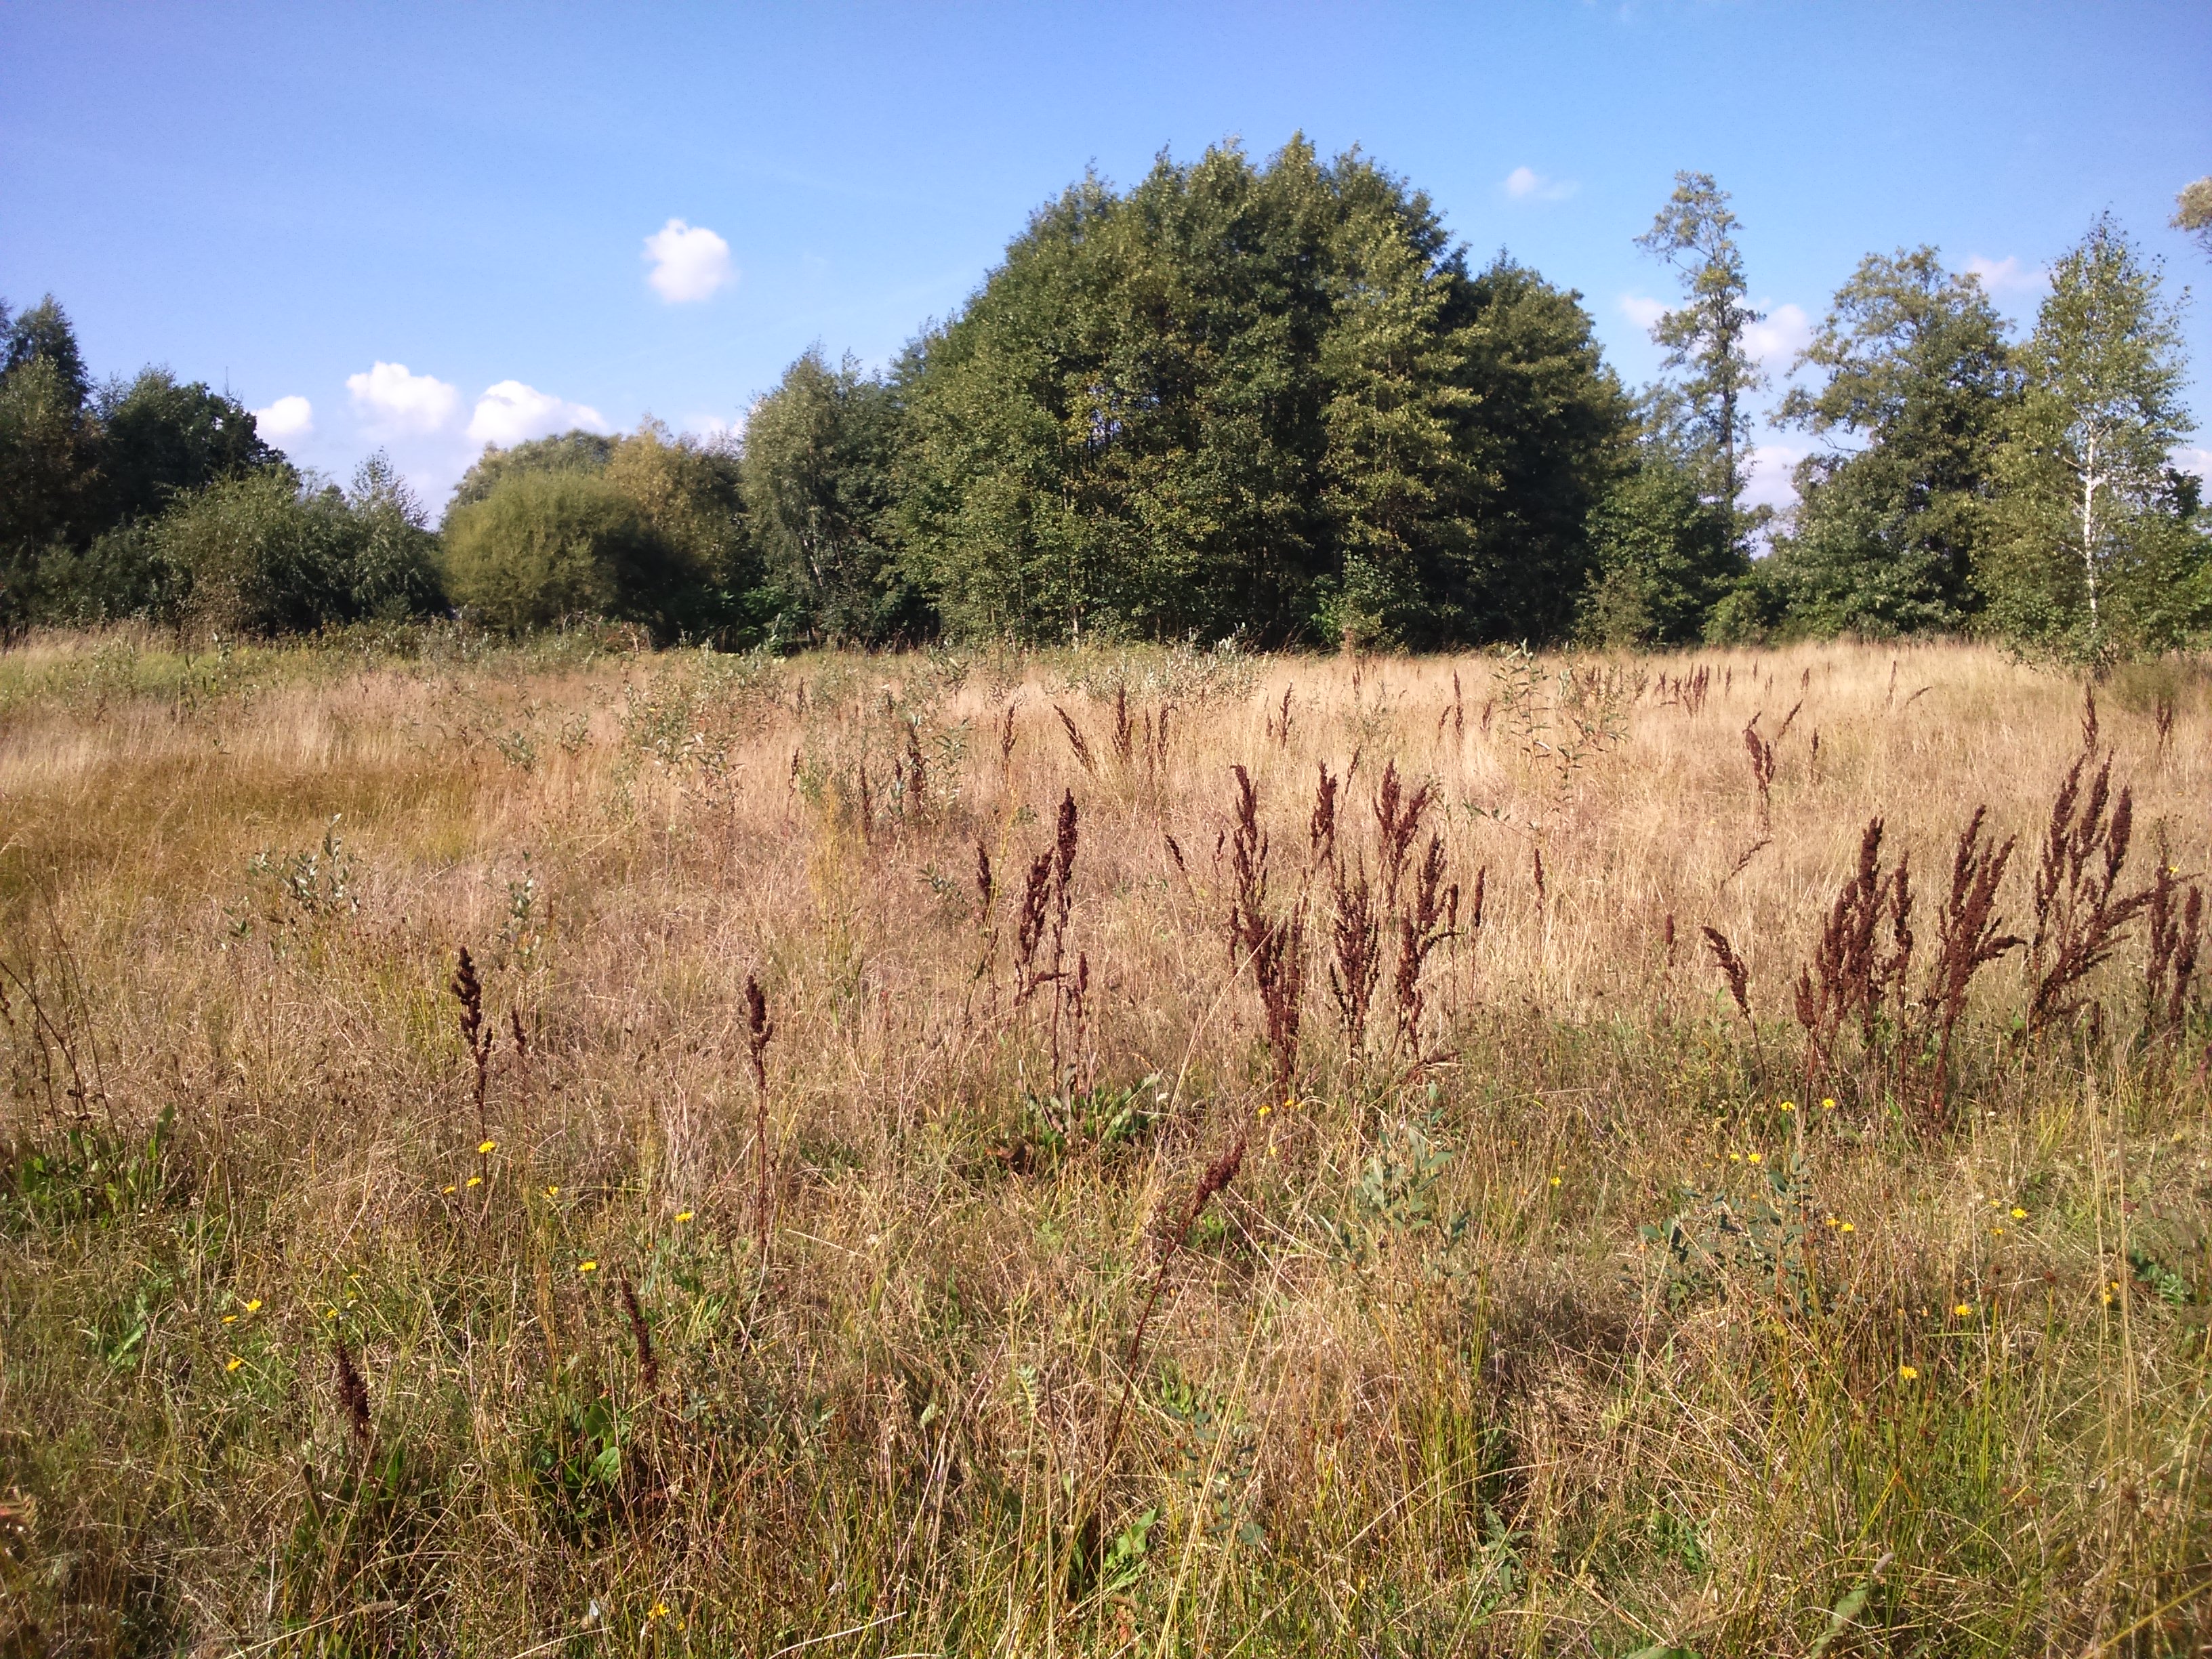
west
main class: Grassland
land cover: Spontaneously vegetated surfaces
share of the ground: > 75 %
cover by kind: herbaceous plants 100 %
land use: Fallow land
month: September
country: PL
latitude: 52.4666
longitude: 21.9062
